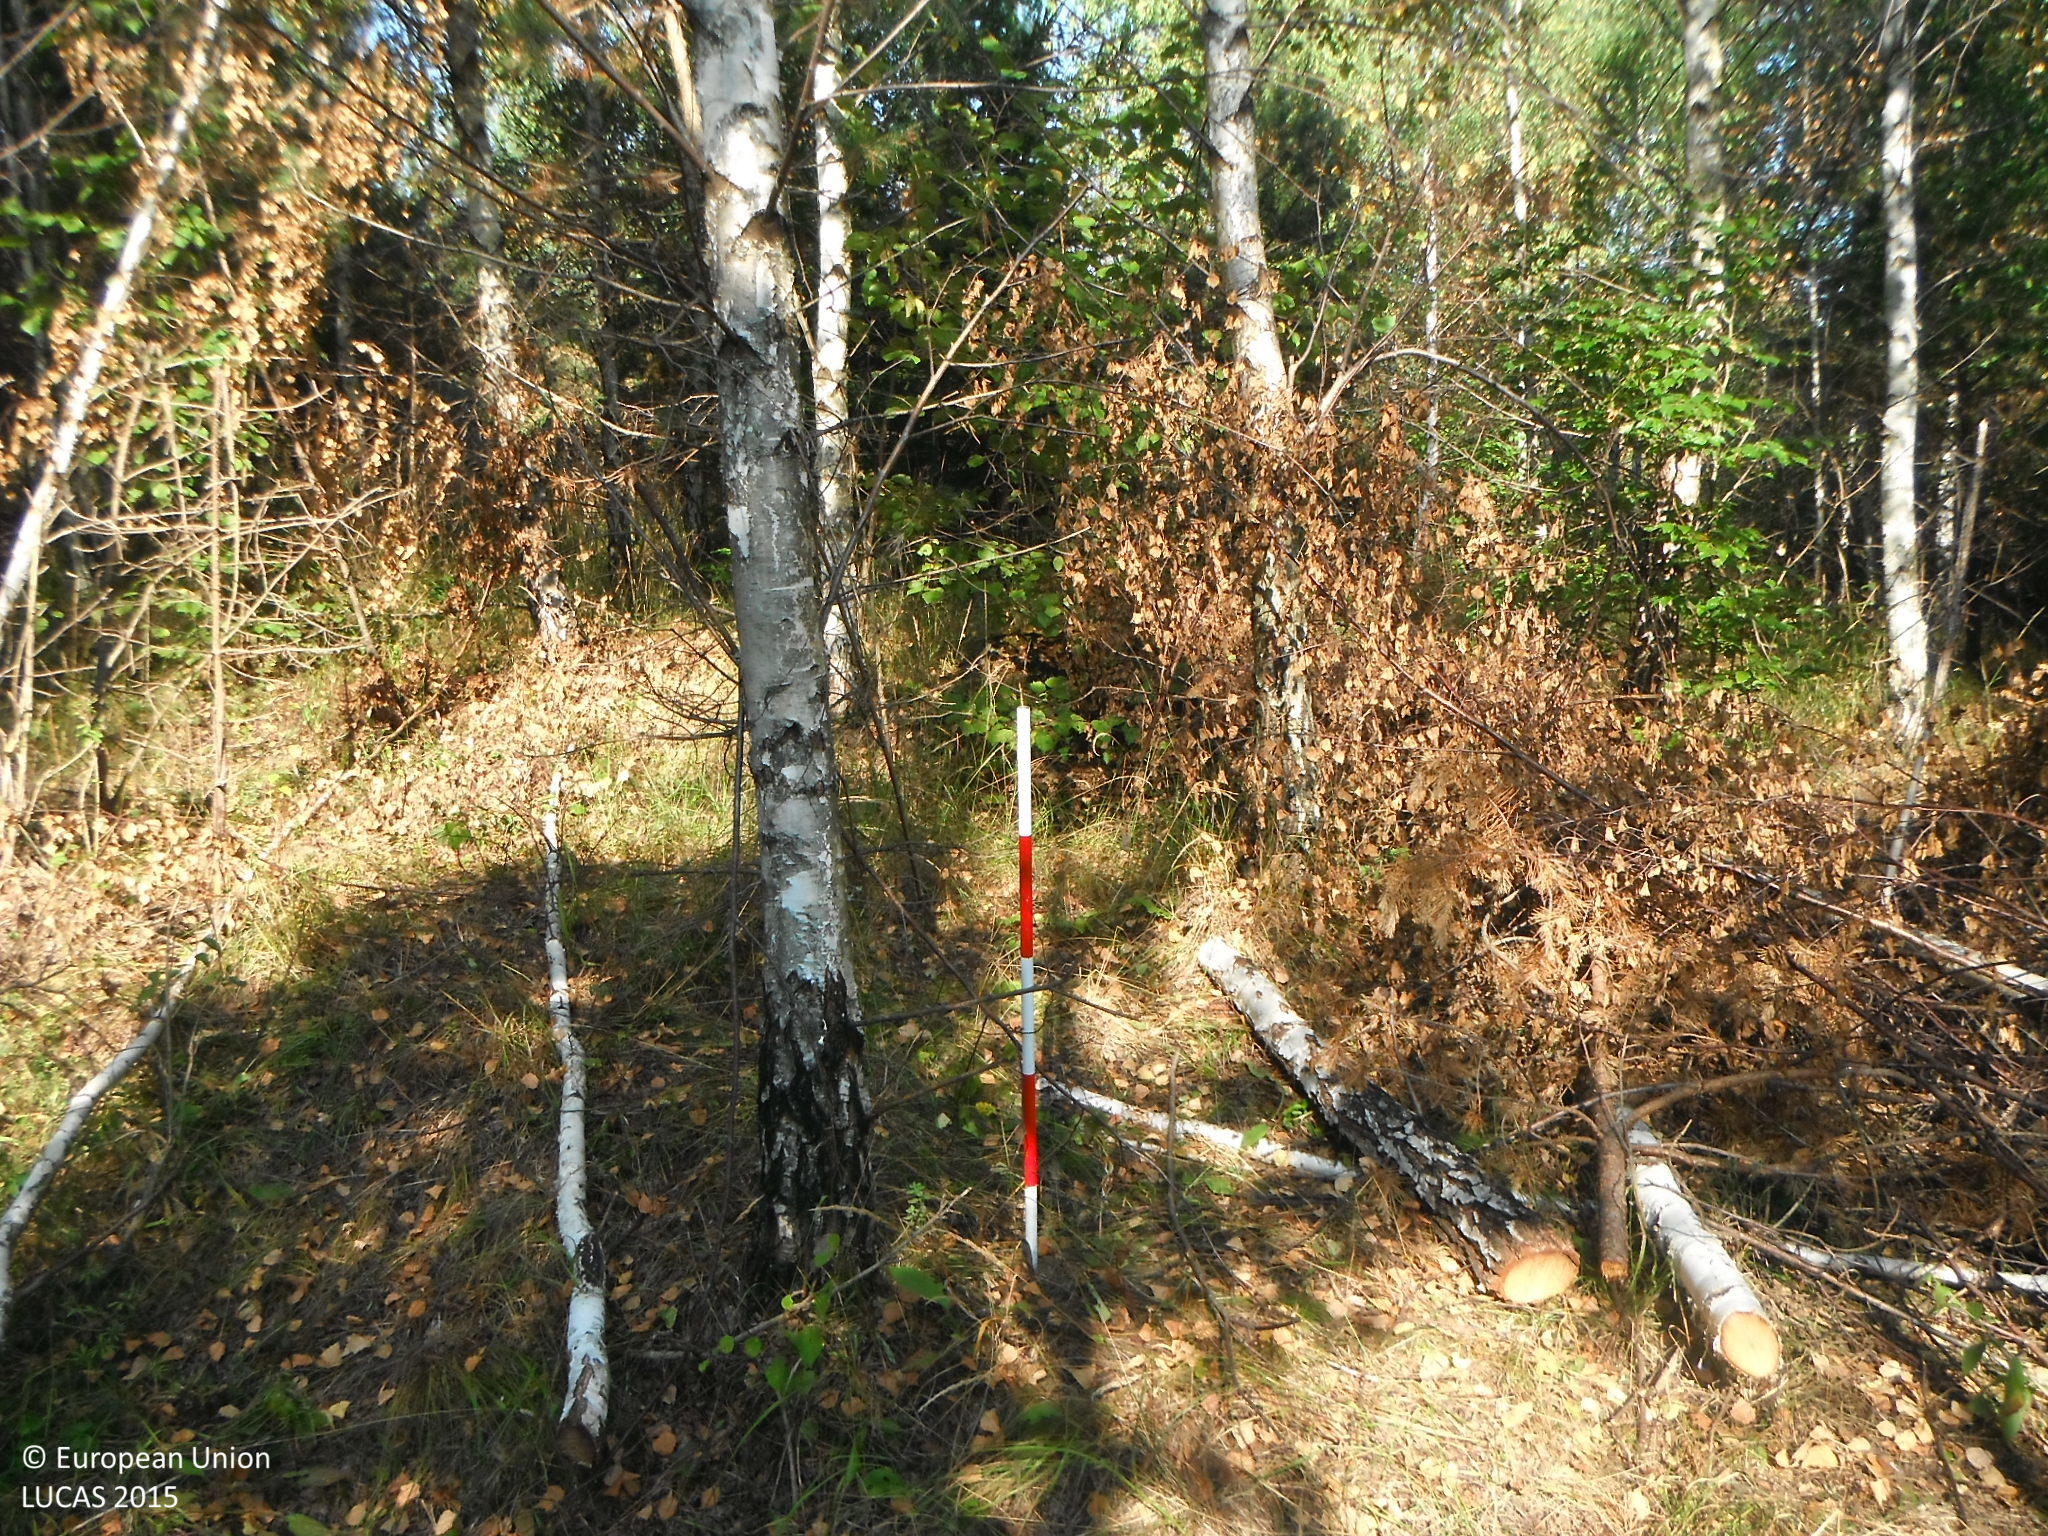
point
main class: Woodland
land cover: Spruce dominated mixed woodland
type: hemiboreal forest and nemoral coniferous forest and mixed broadleaved-coniferous forest
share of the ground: > 75 %
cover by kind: coniferous forest trees 60 %, broadleaved forest trees 40 %
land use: Forestry
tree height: > 5 m
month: September
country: SK
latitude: 48.9686
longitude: 20.3478
